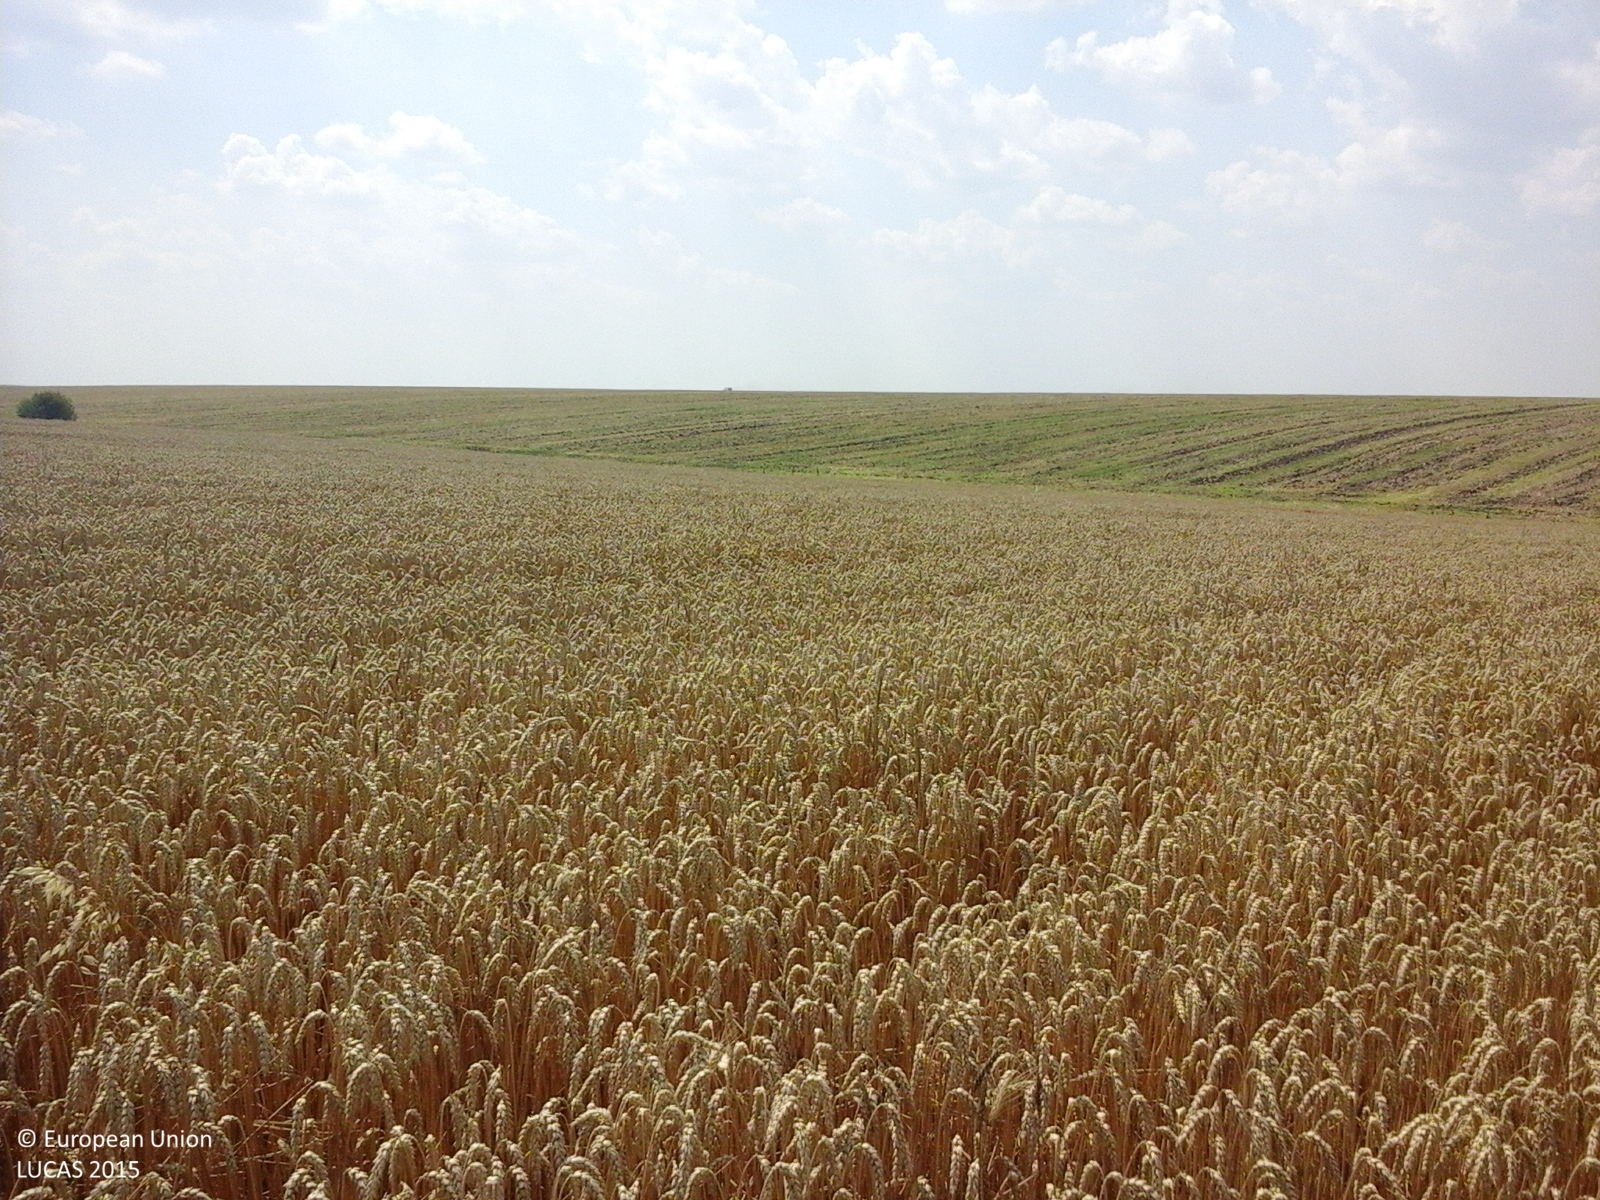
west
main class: Cropland
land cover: Common wheat
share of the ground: > 75 %
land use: Agriculture (excluding fallow land and kitchen gardens)
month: July
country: RO
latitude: 43.9780
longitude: 25.1763
